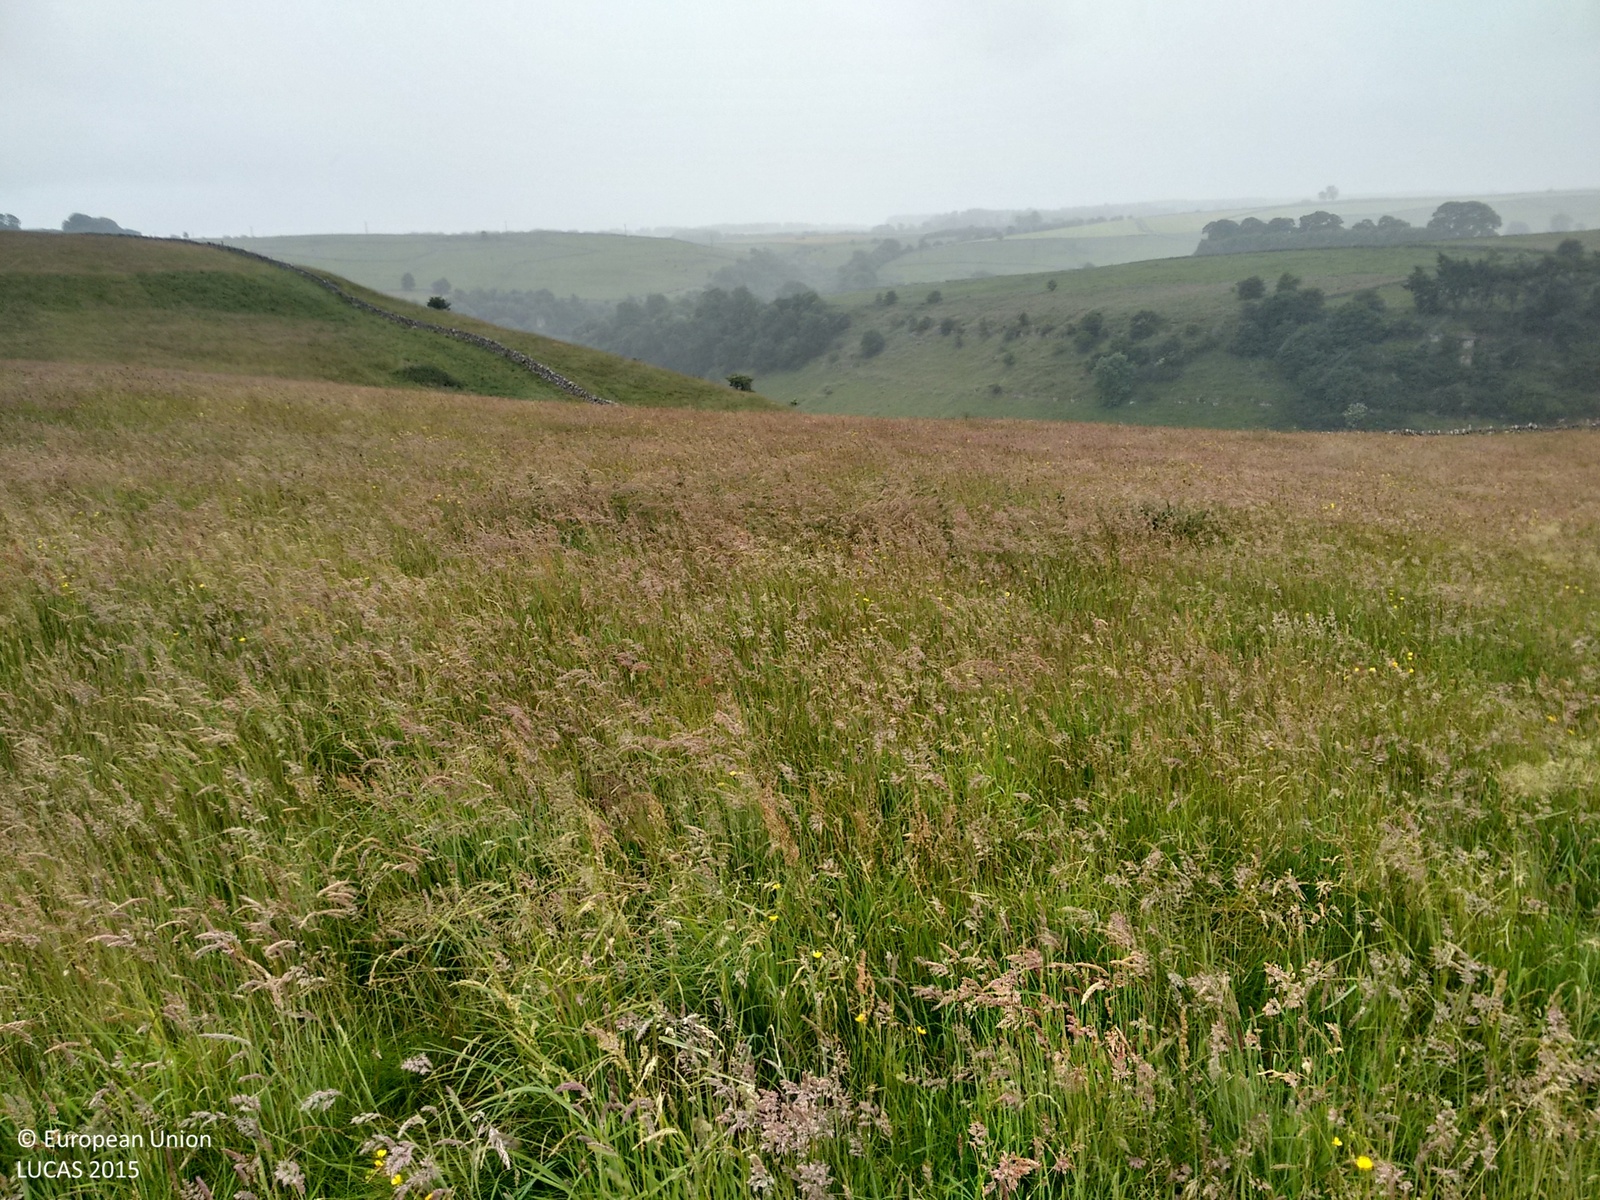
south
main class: Grassland
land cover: Grassland without tree/shrub cover
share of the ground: > 75 %
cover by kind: herbaceous plants 100 %
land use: Agriculture (excluding fallow land and kitchen gardens)
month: July
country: GB
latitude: 53.1917
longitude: -1.7432
